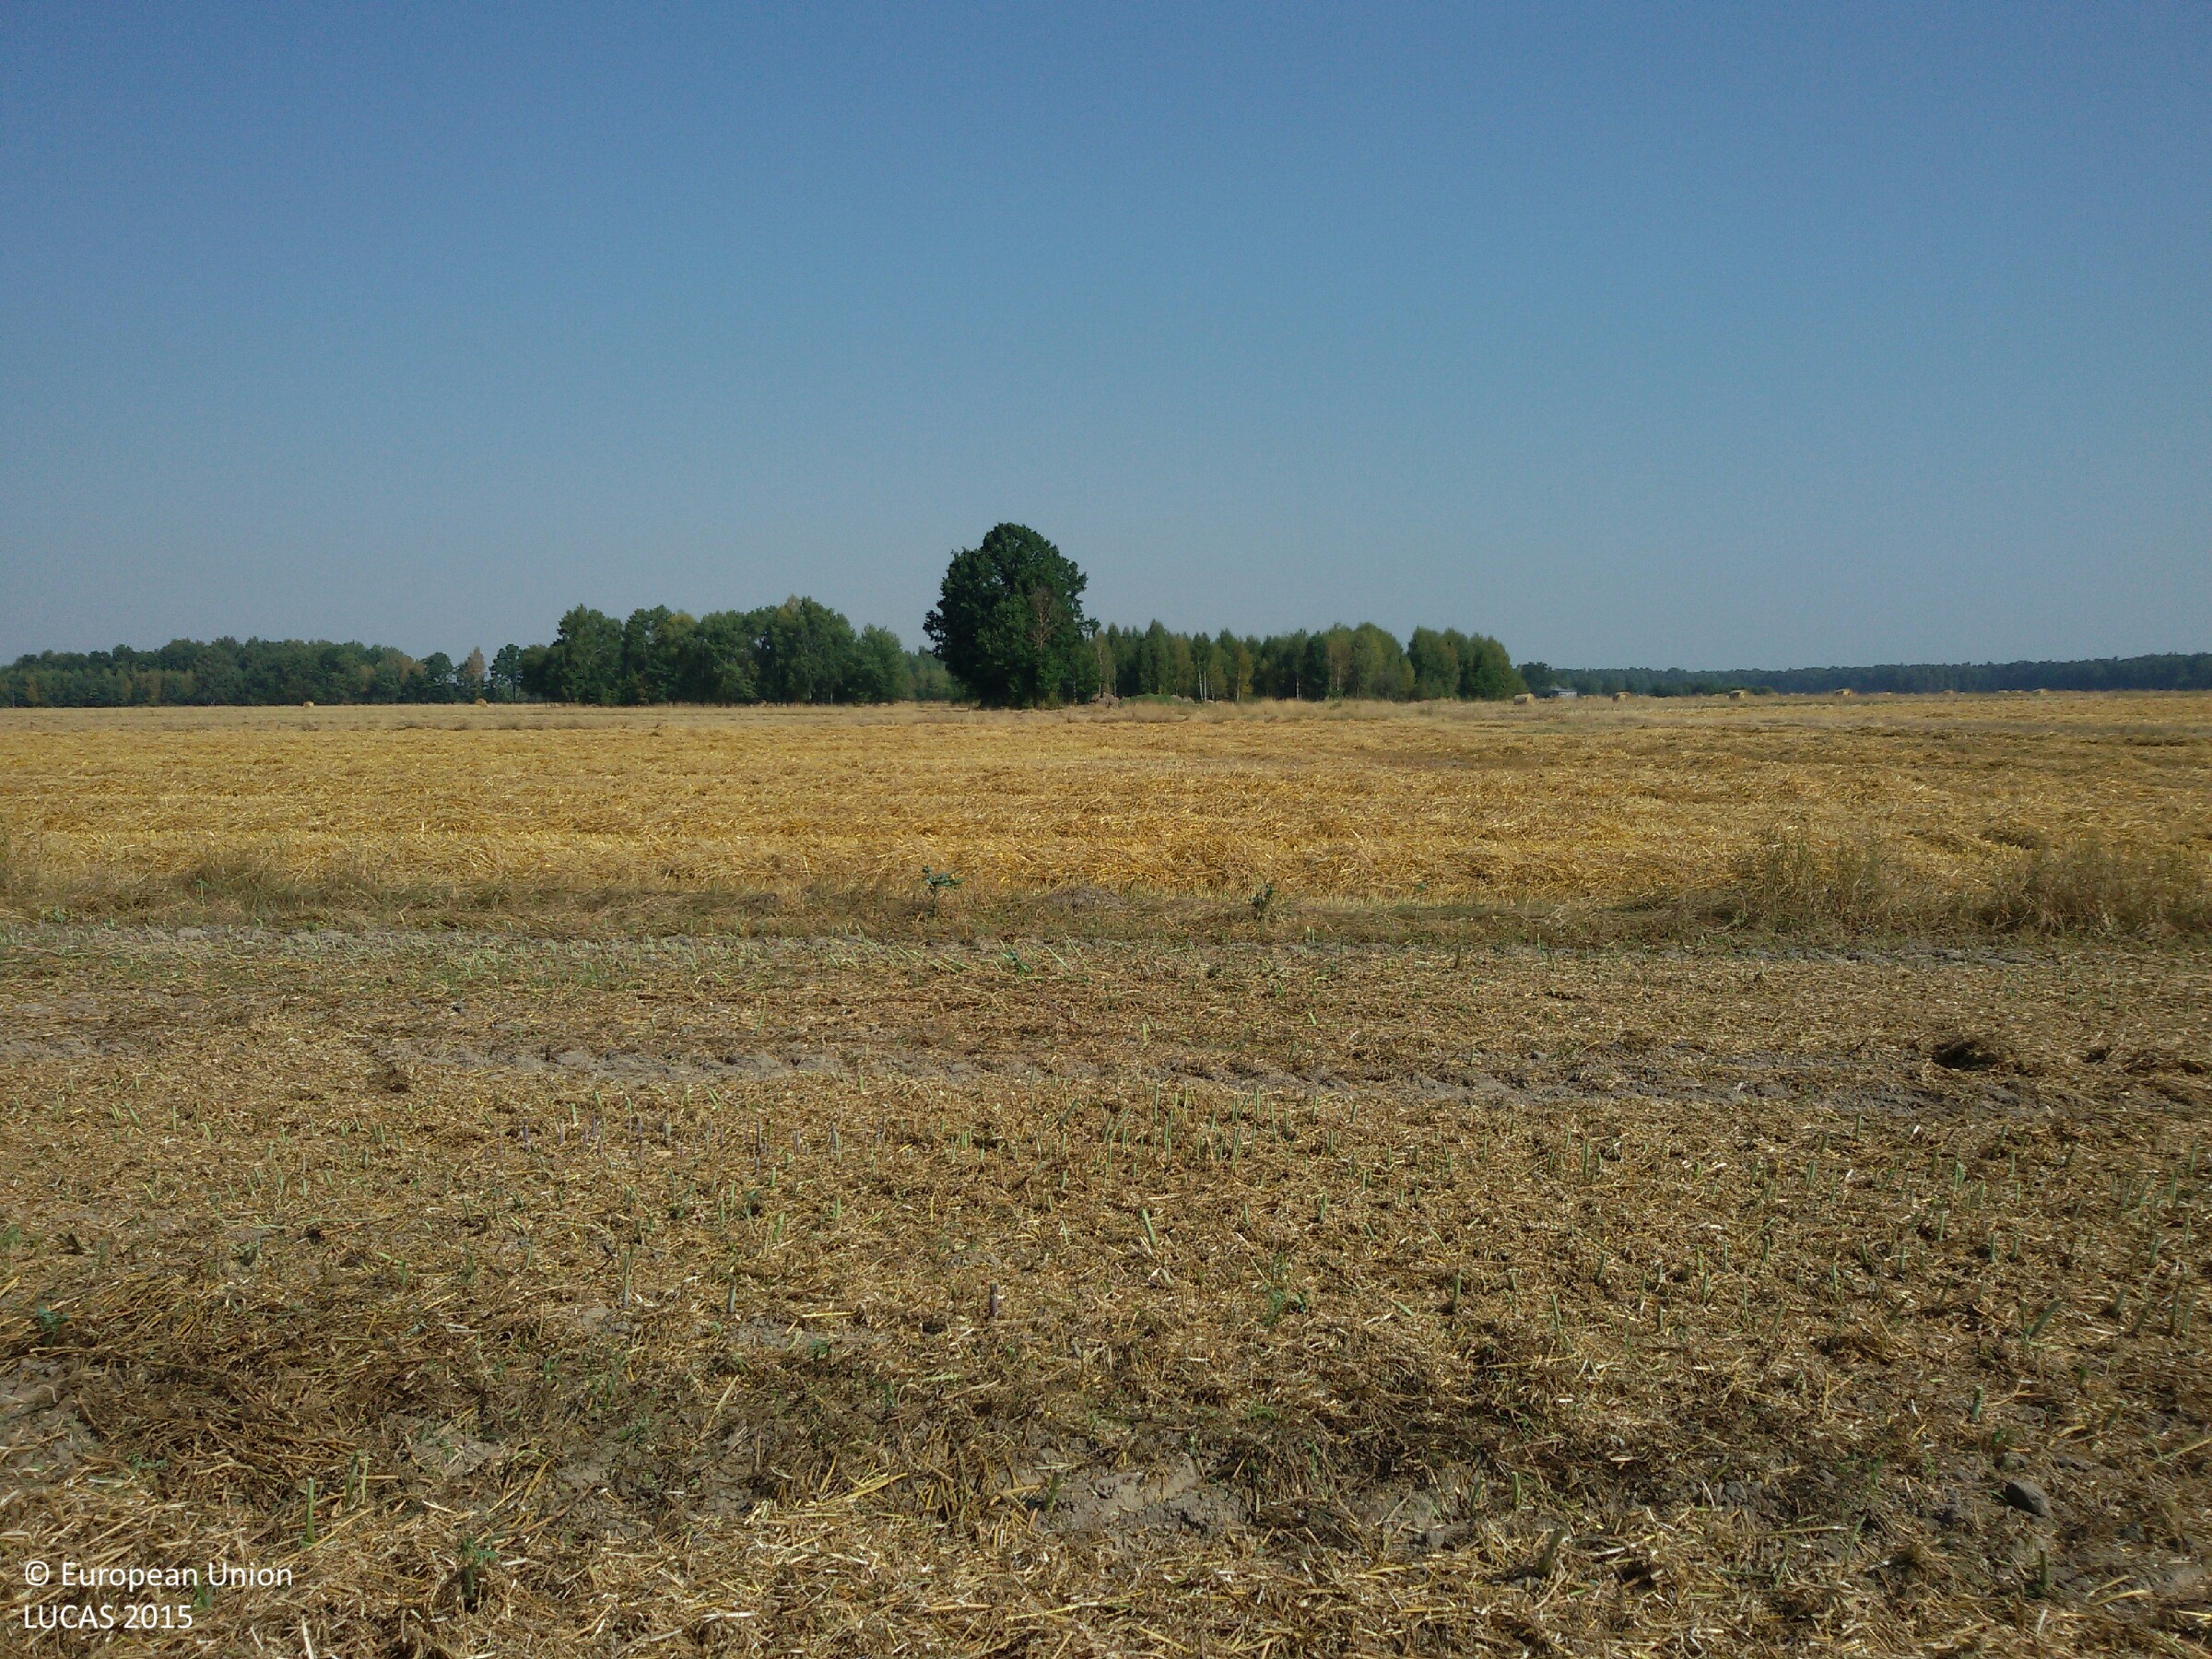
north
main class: Cropland
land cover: Barley
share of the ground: 50 - 75 %
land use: Agriculture (excluding fallow land and kitchen gardens)
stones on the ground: < 10 %
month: August
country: PL
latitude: 51.6763
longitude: 22.8418
